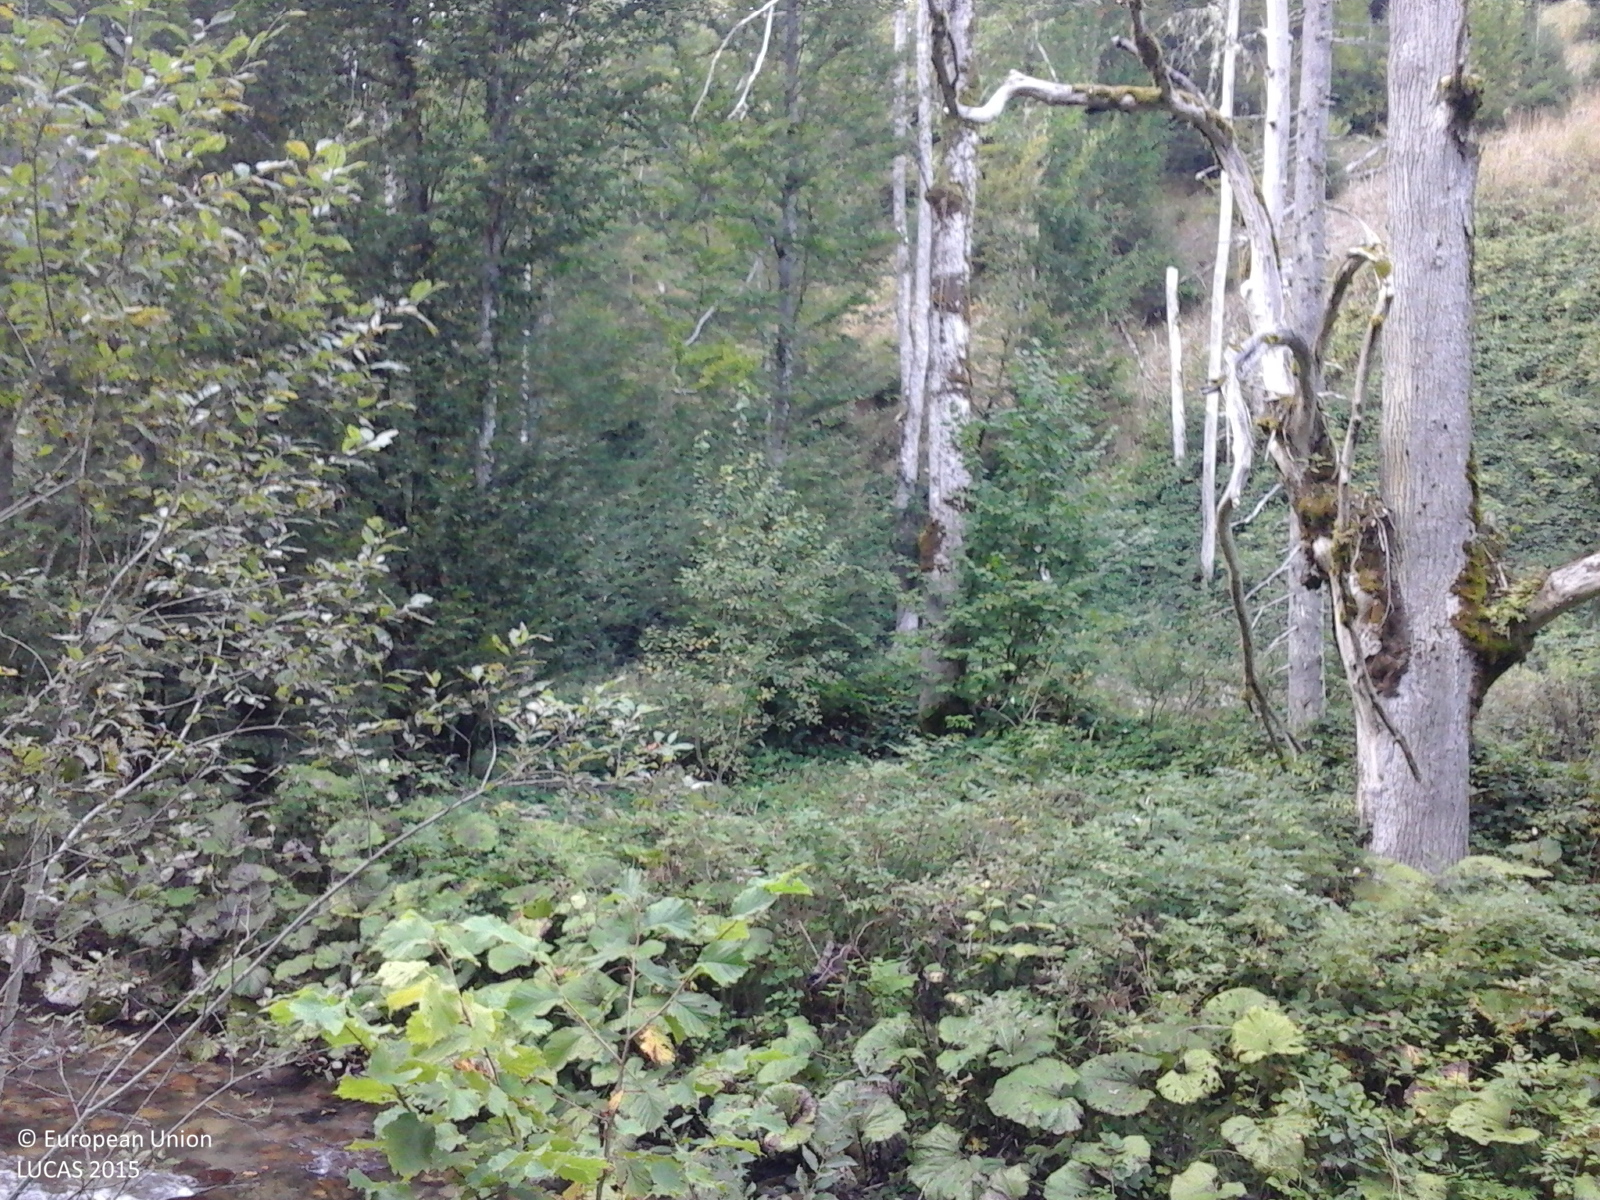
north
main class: Woodland
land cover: Spruce dominated mixed woodland
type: alpine coniferous forest
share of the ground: 50 - 75 %
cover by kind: coniferous forest trees 60 %, broadleaved forest trees 40 %
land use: Forestry
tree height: > 5 m
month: September
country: RO
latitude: 45.3870
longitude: 22.5752
